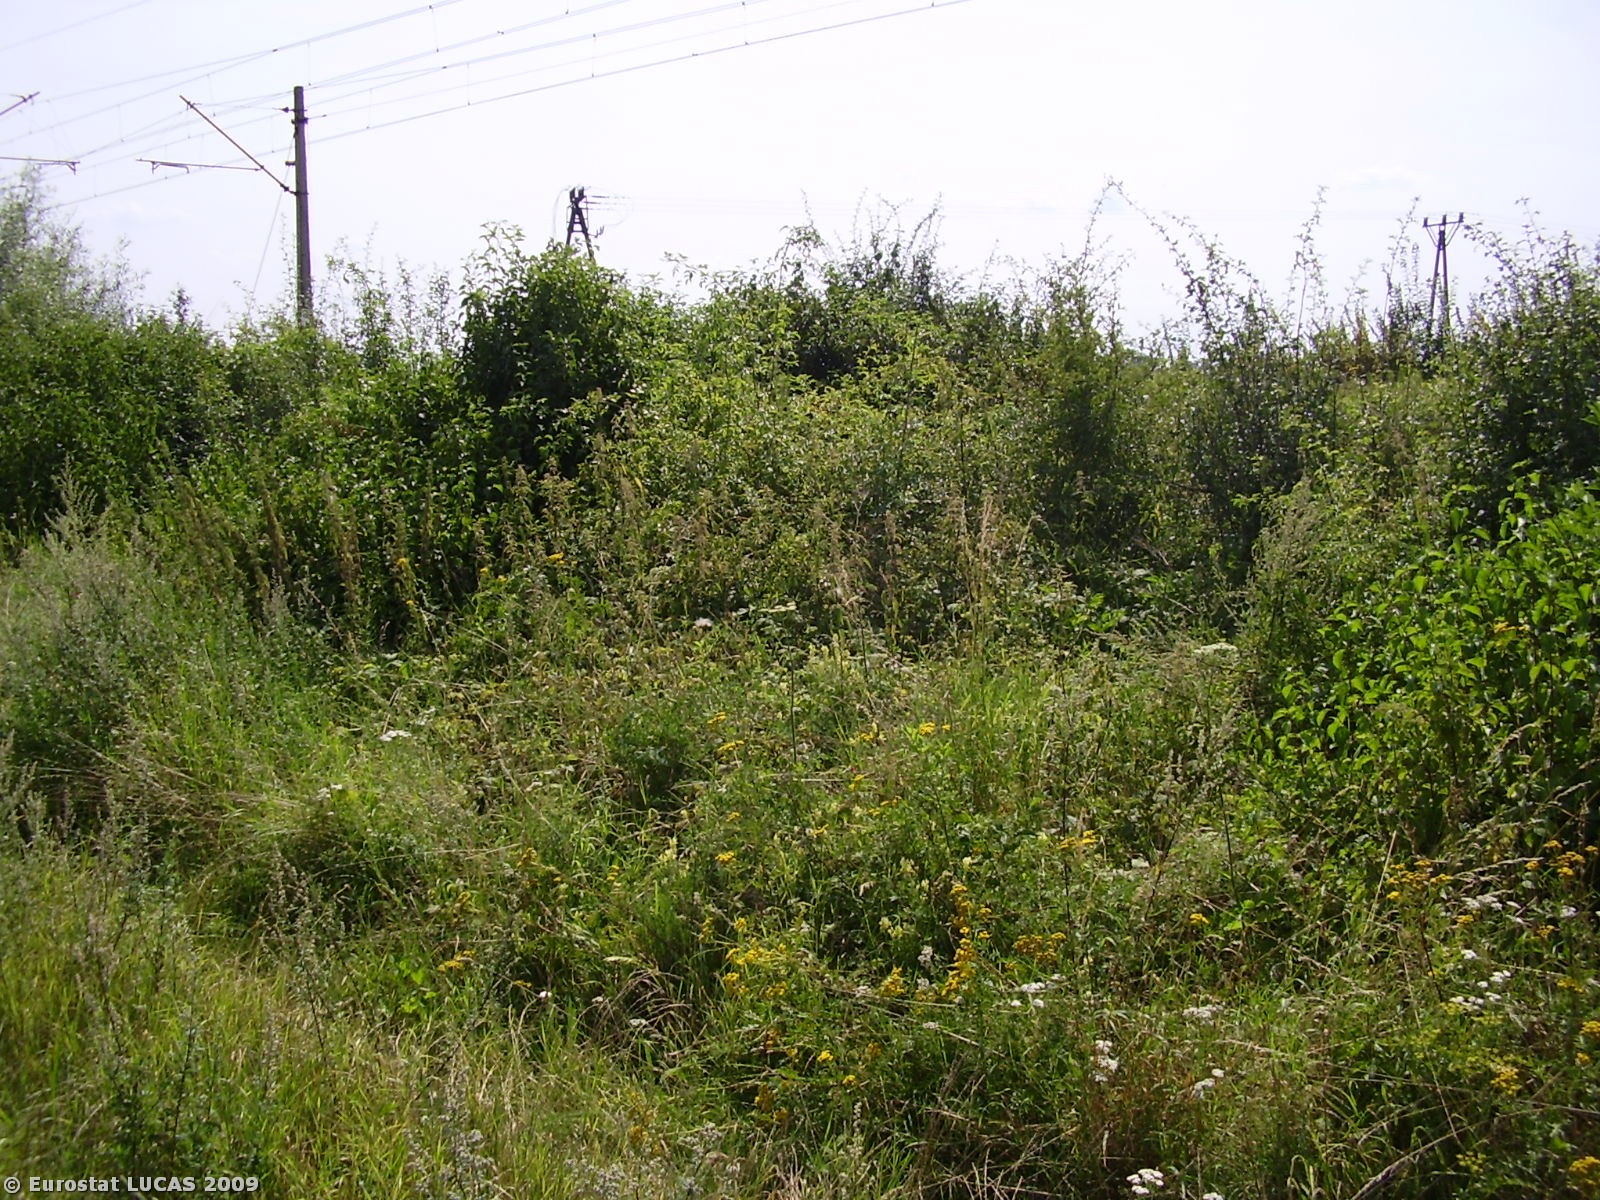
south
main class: Cropland
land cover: Common wheat
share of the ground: < 10 %
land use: Agriculture (excluding fallow land and kitchen gardens)
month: August
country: PL
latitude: 51.6039
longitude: 16.1717
